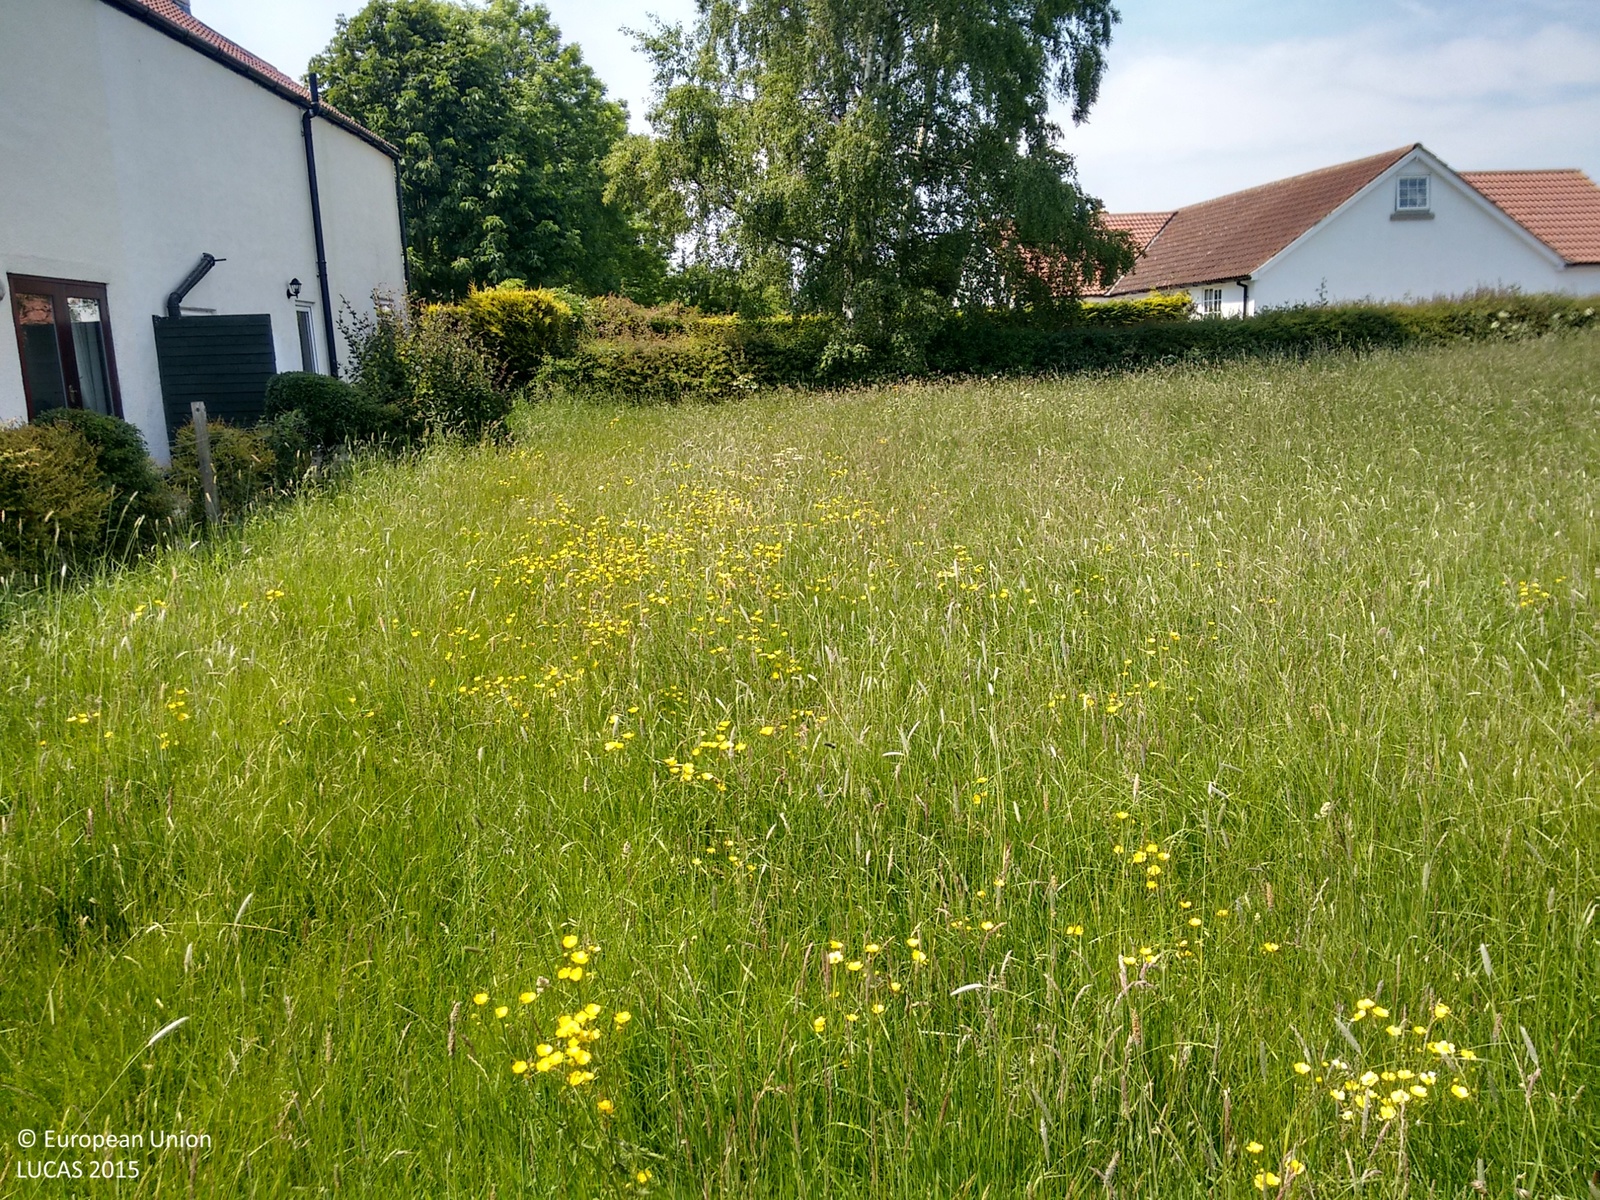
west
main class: Grassland
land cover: Grassland without tree/shrub cover
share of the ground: > 75 %
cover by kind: herbaceous plants 95 %, shrubs 5 %
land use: Agriculture (excluding fallow land and kitchen gardens)
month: June
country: GB
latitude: 53.8088
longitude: -1.1767
